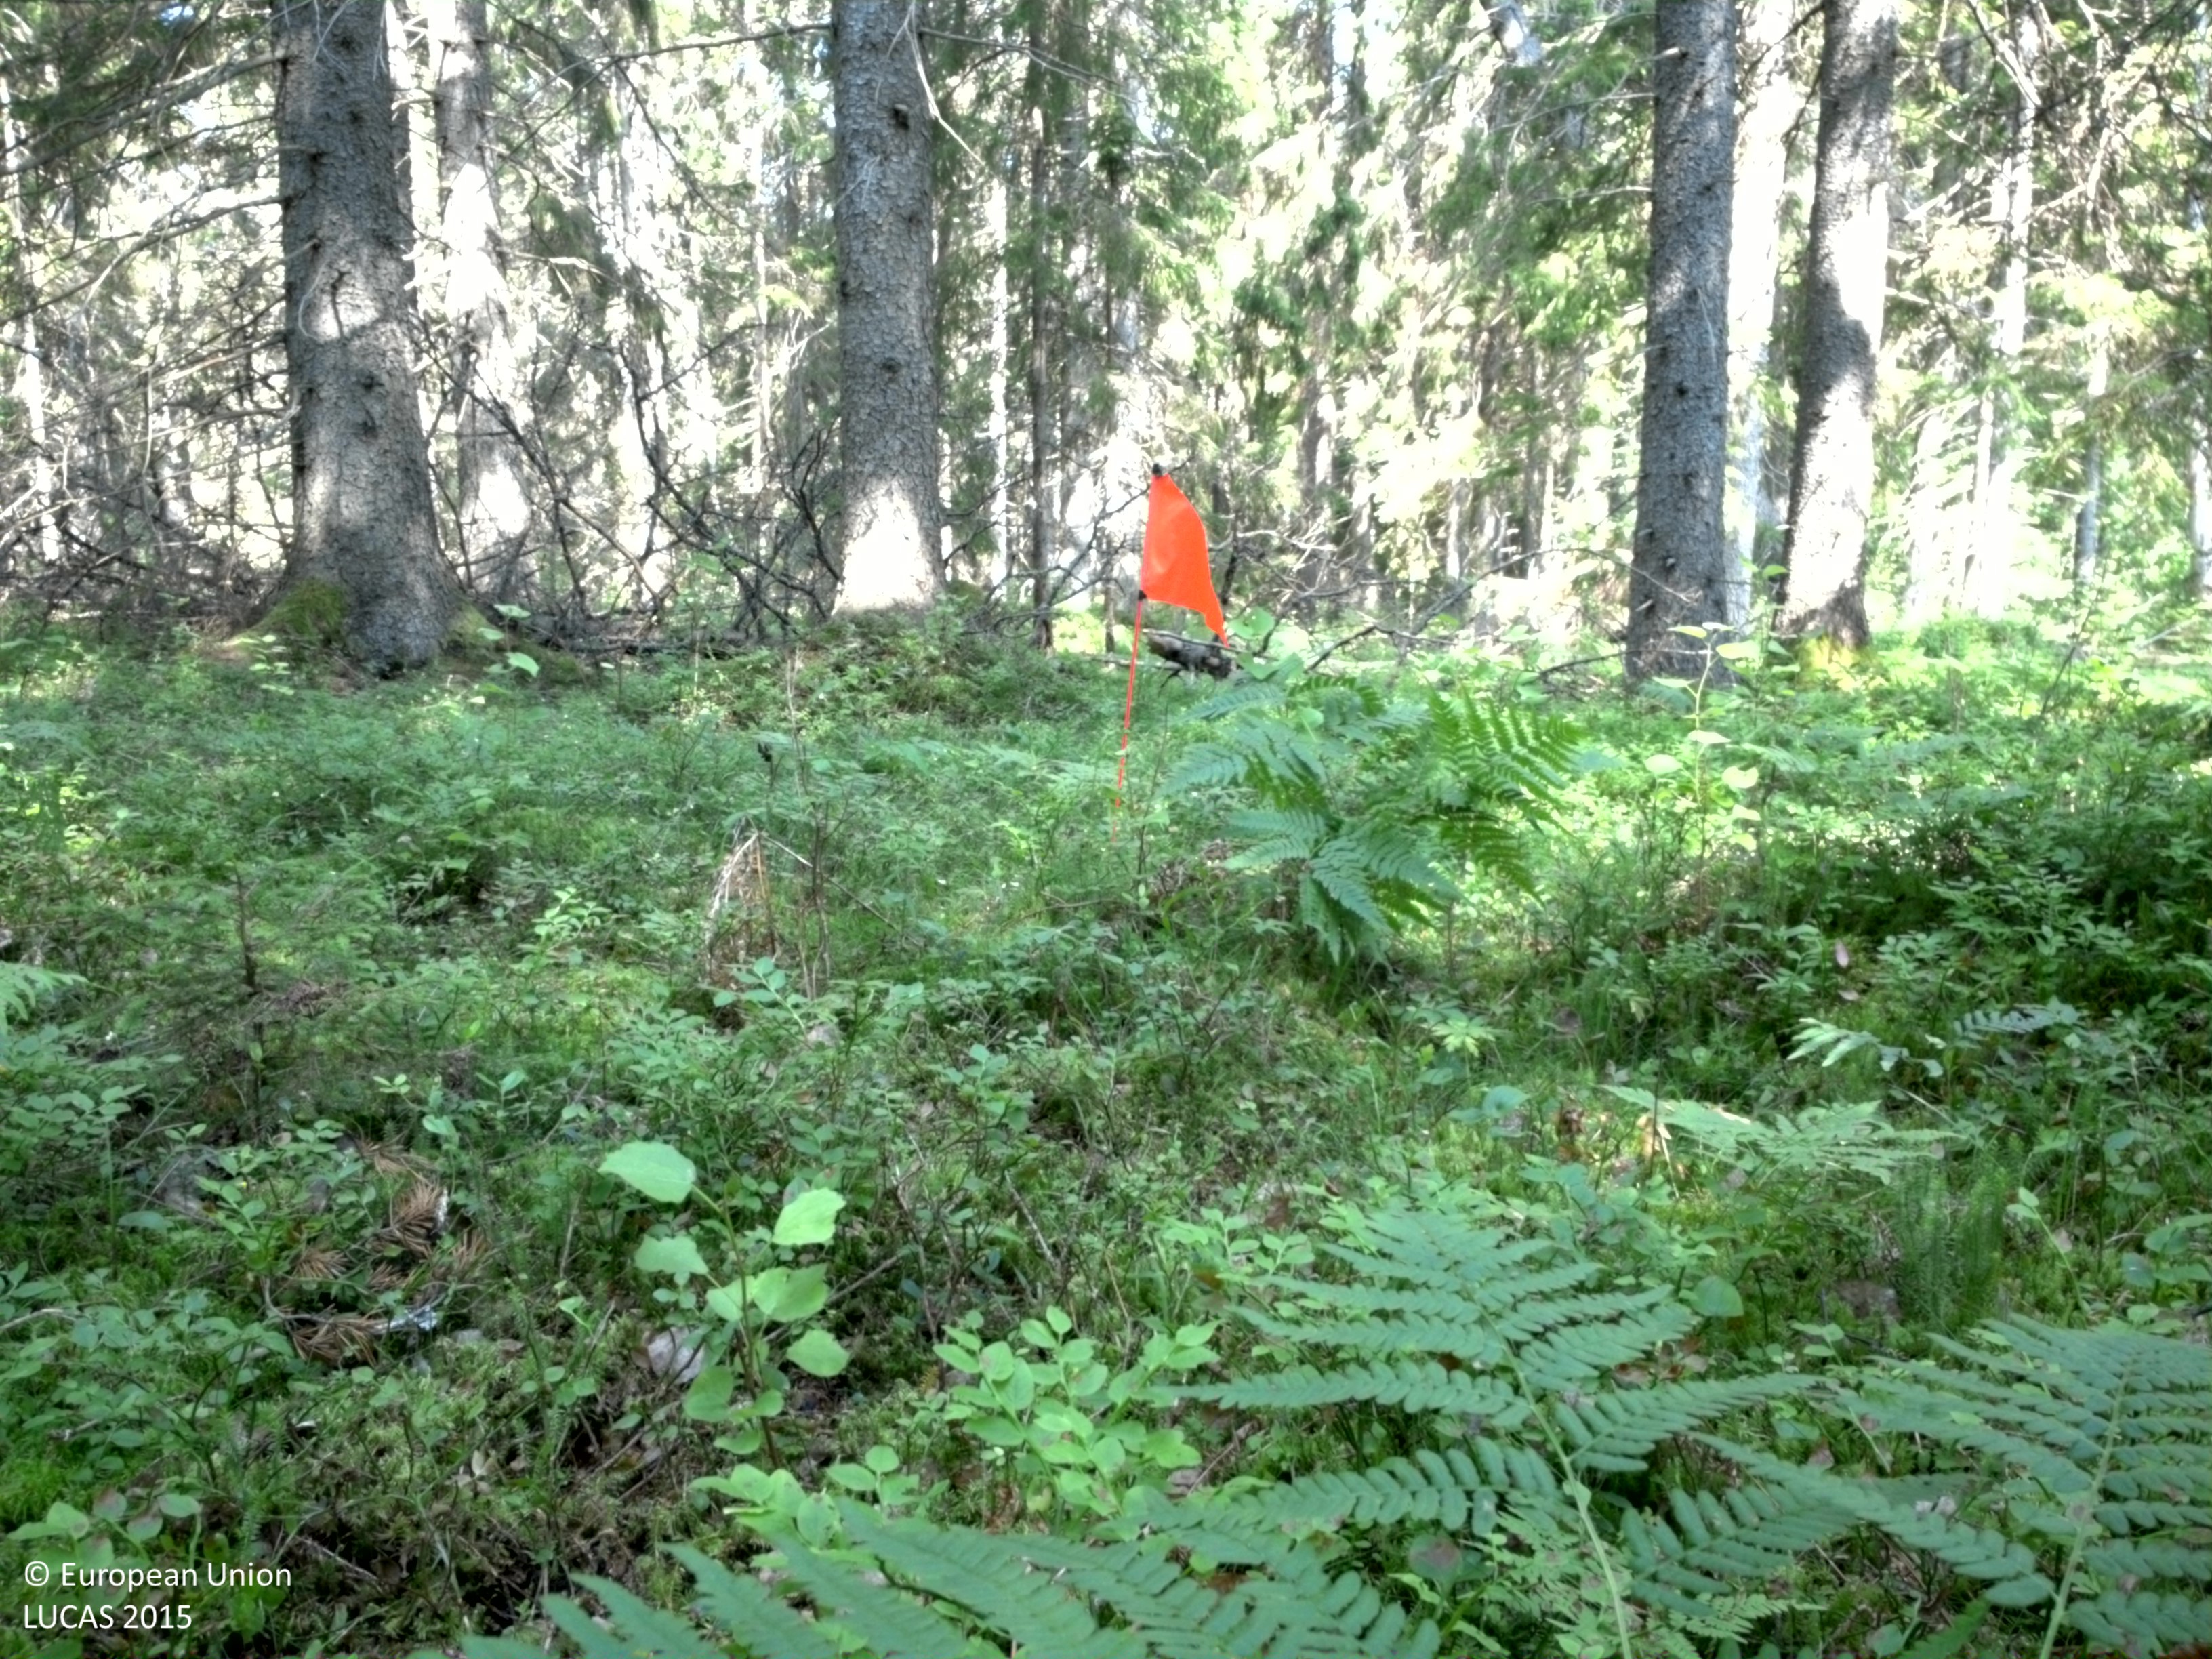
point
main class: Woodland
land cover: Spruce dominated coniferous woodland
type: boreal forest
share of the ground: 50 - 75 %
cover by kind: coniferous forest trees 60 %, lichens and mosses 25 %, herbaceous plants 10 %, broadleaved forest trees 5 %
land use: Amenities, museums, leisure
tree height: > 5 m
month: July
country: SE
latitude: 59.6457
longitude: 18.6043
